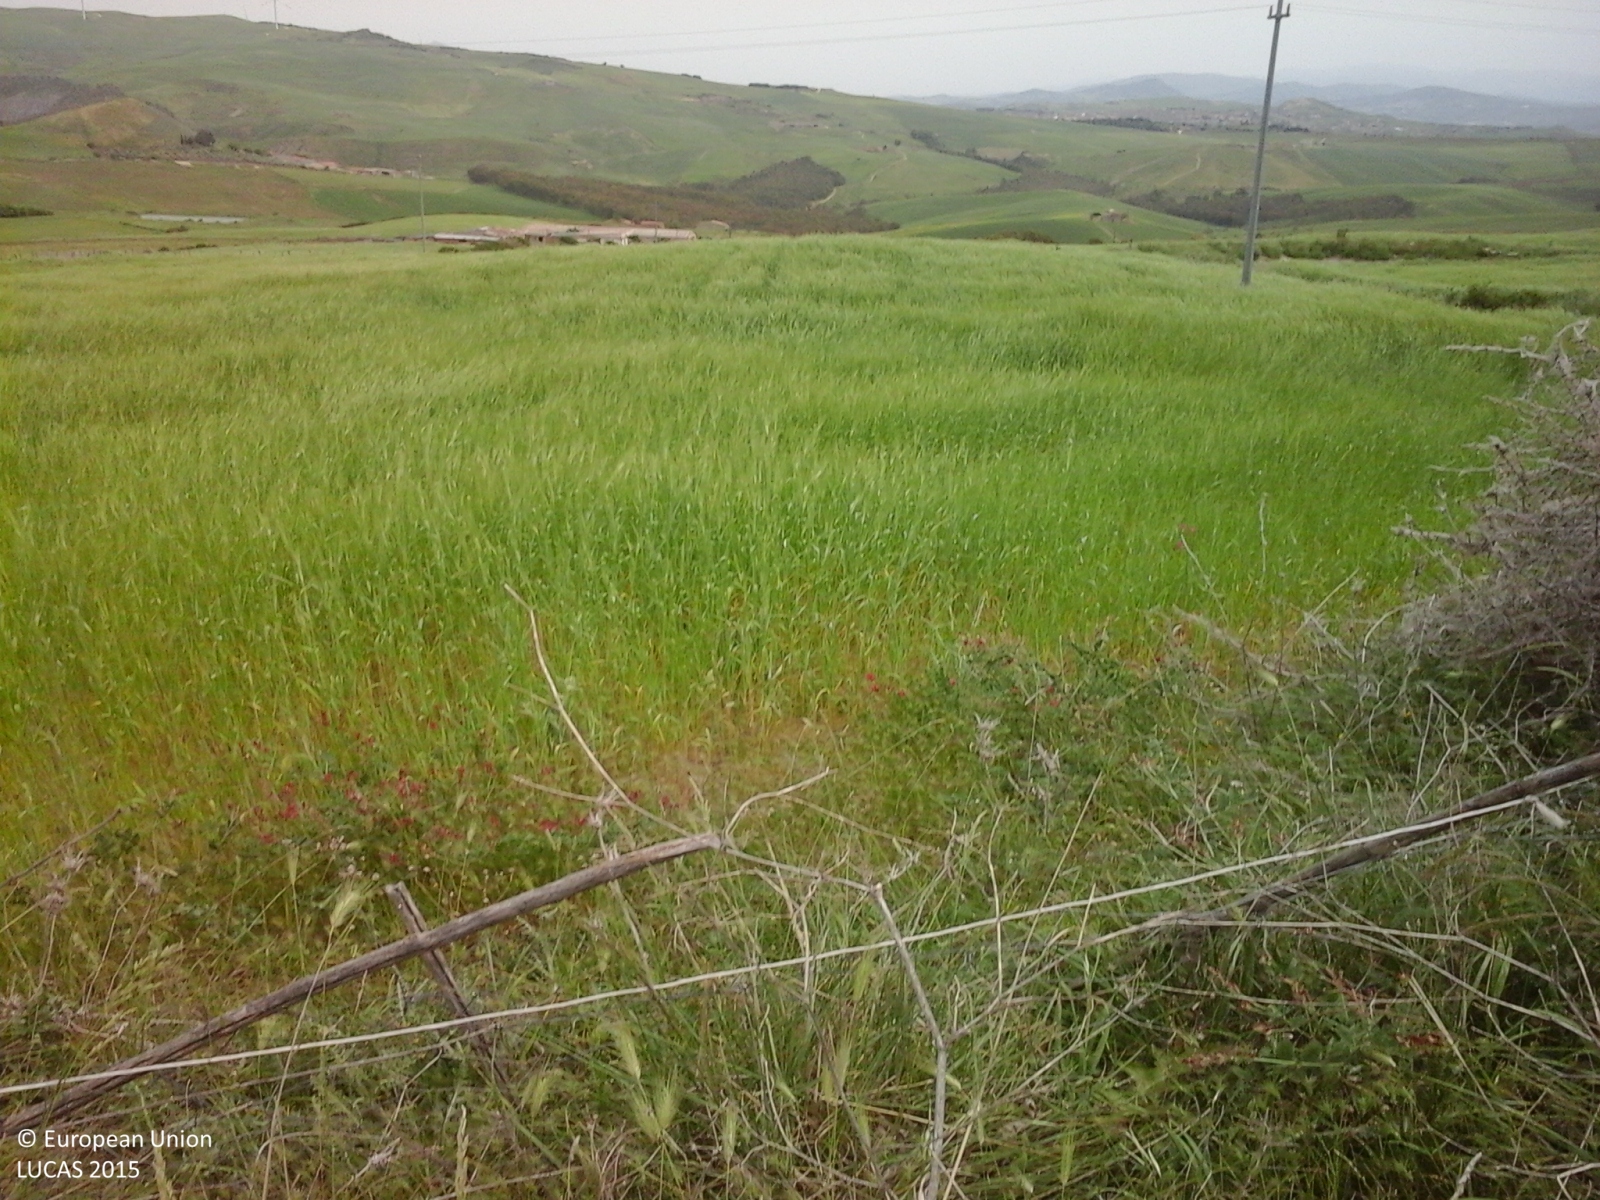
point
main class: Cropland
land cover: Durum wheat
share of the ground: > 75 %
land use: Agriculture (excluding fallow land and kitchen gardens)
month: May
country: IT
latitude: 37.7177
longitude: 13.5474
